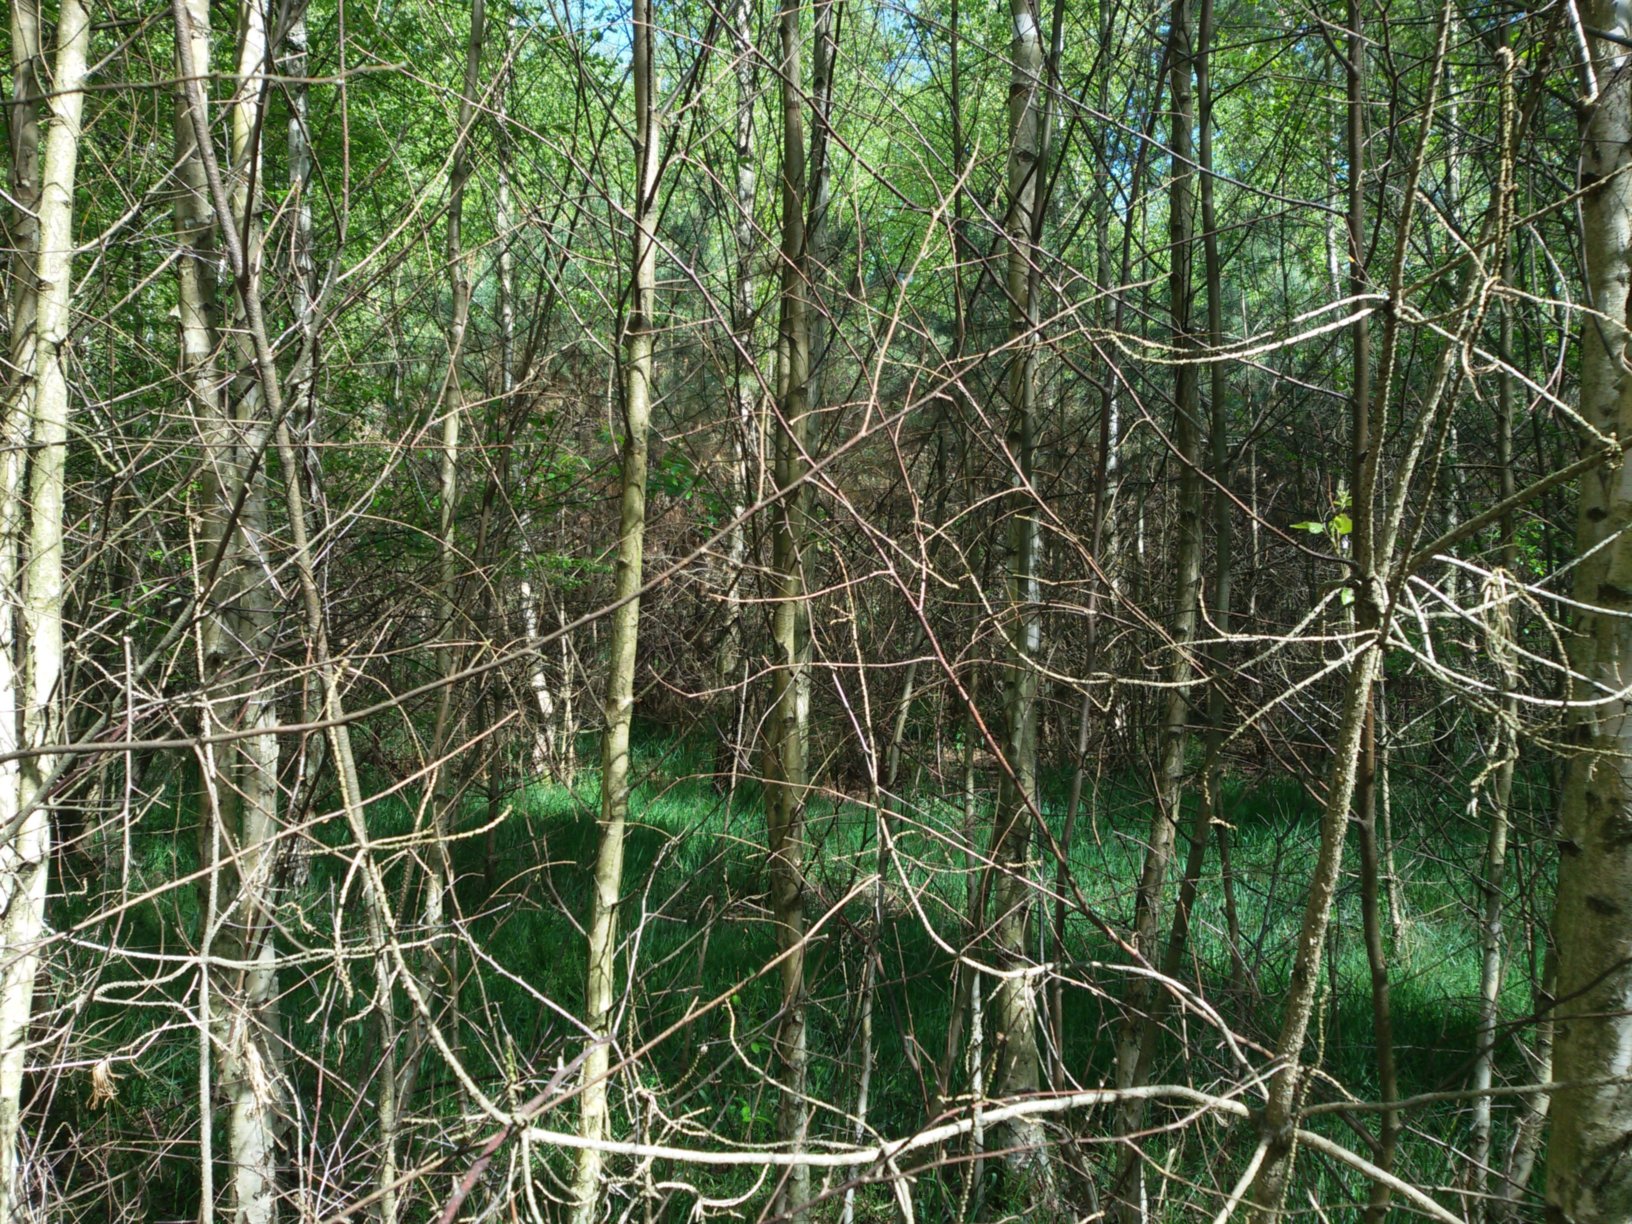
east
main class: Woodland
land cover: Broadleaved woodland
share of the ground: > 75 %
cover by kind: broadleaved forest trees 80 %, lichens and mosses 20 %
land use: Forestry
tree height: > 5 m
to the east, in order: Broadleaved woodland; Pine dominated mixed woodland; Tracks; Pine dominated mixed woodland; Broadleaved woodland; Pine dominated mixed woodland; Shrubland with sparse tree cover
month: April
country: PL
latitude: 51.5170
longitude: 15.7549
